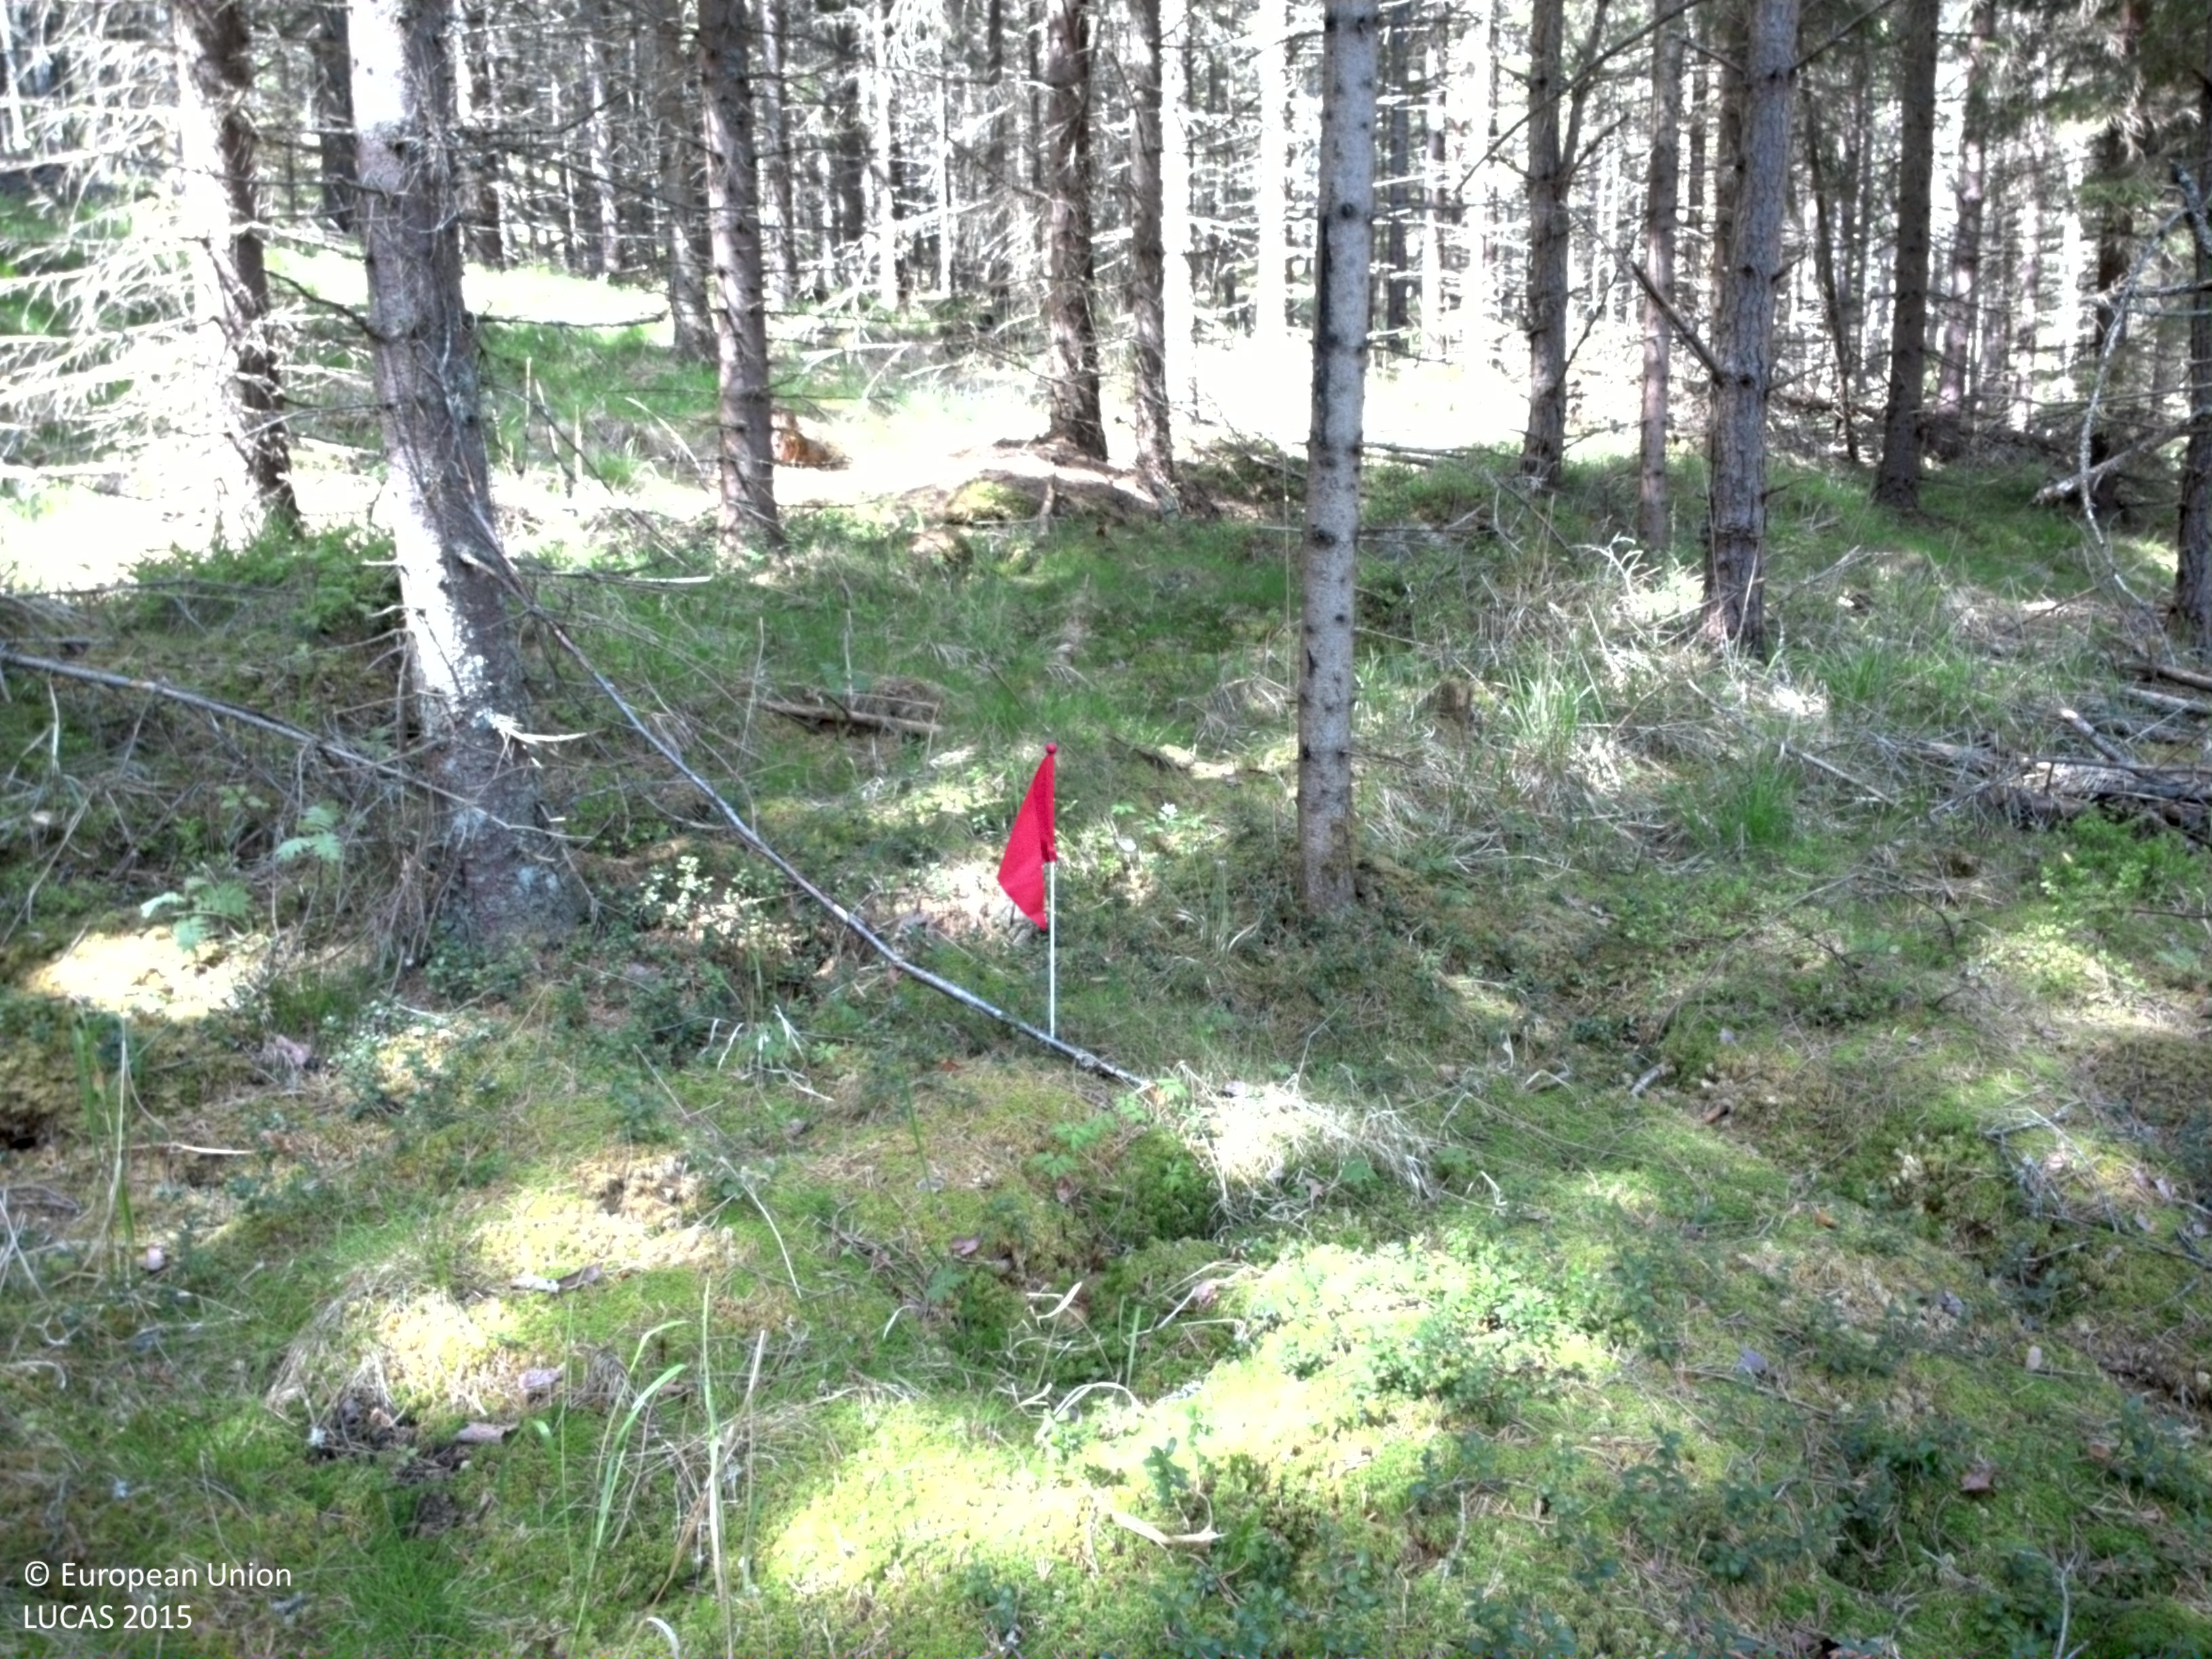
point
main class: Woodland
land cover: Spruce dominated coniferous woodland
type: boreal forest
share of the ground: > 75 %
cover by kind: coniferous forest trees 70 %, herbaceous plants 15 %, lichens and mosses 10 %, broadleaved forest trees 5 %
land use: Forestry
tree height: > 5 m
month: May
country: SE
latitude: 59.5135
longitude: 12.3090
